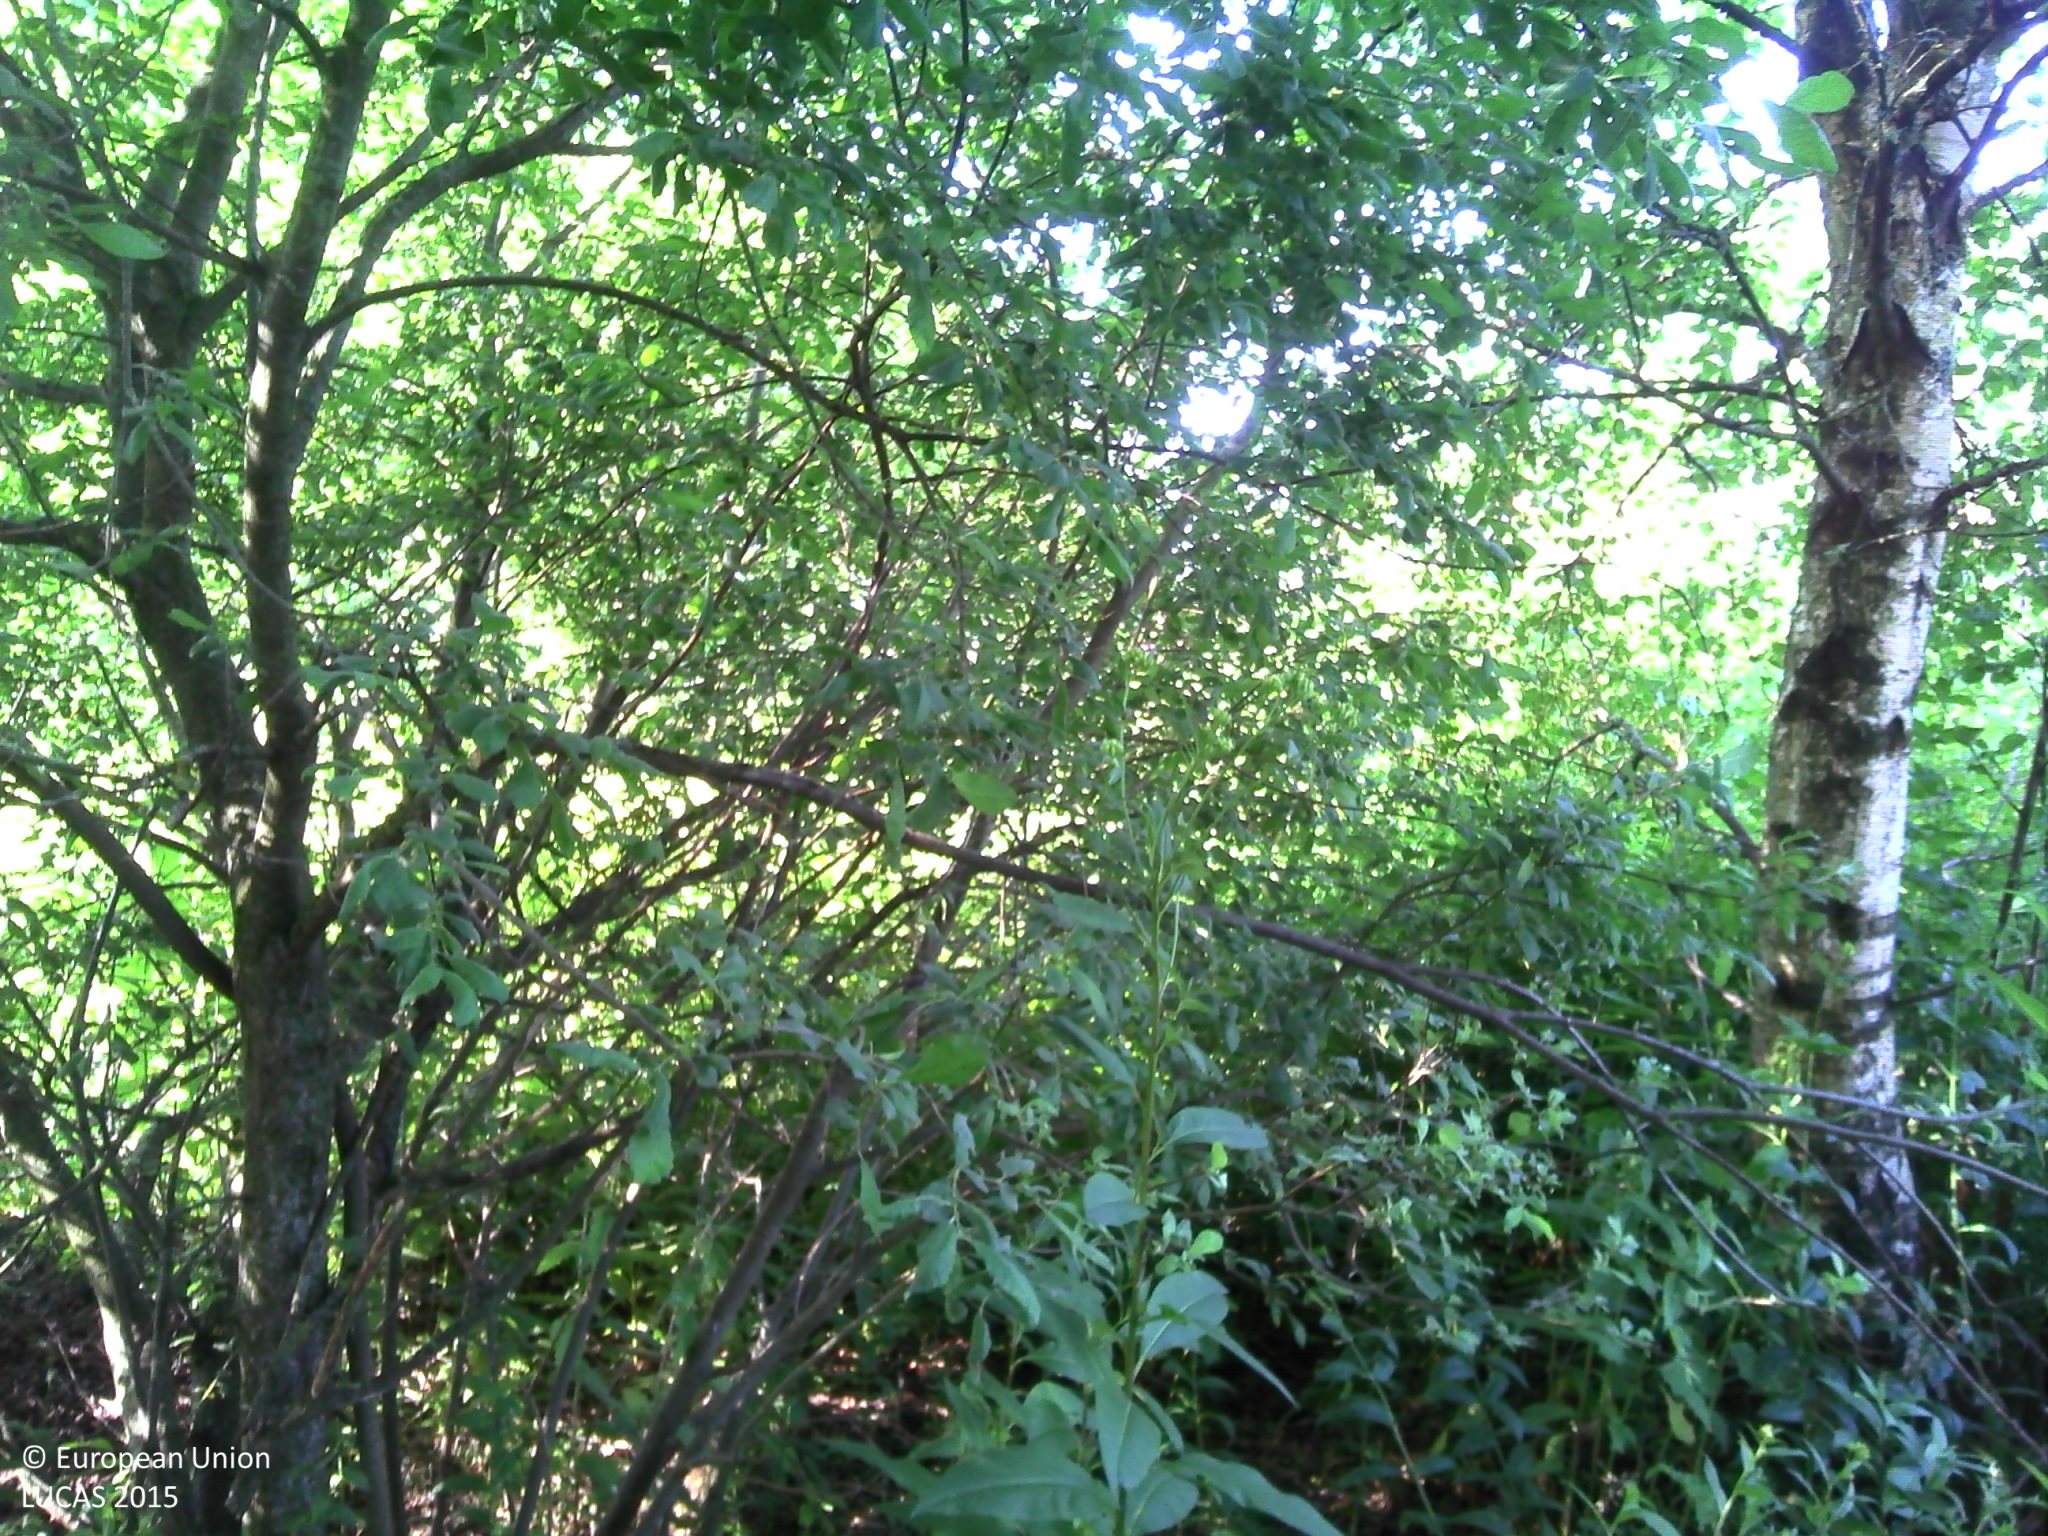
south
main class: Woodland
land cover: Broadleaved woodland
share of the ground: > 75 %
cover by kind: broadleaved forest trees 95 %, herbaceous plants 5 %
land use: Semi-natural and natural areas not in use
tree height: > 5 m
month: July
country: BE
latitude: 50.0116
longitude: 5.6588
